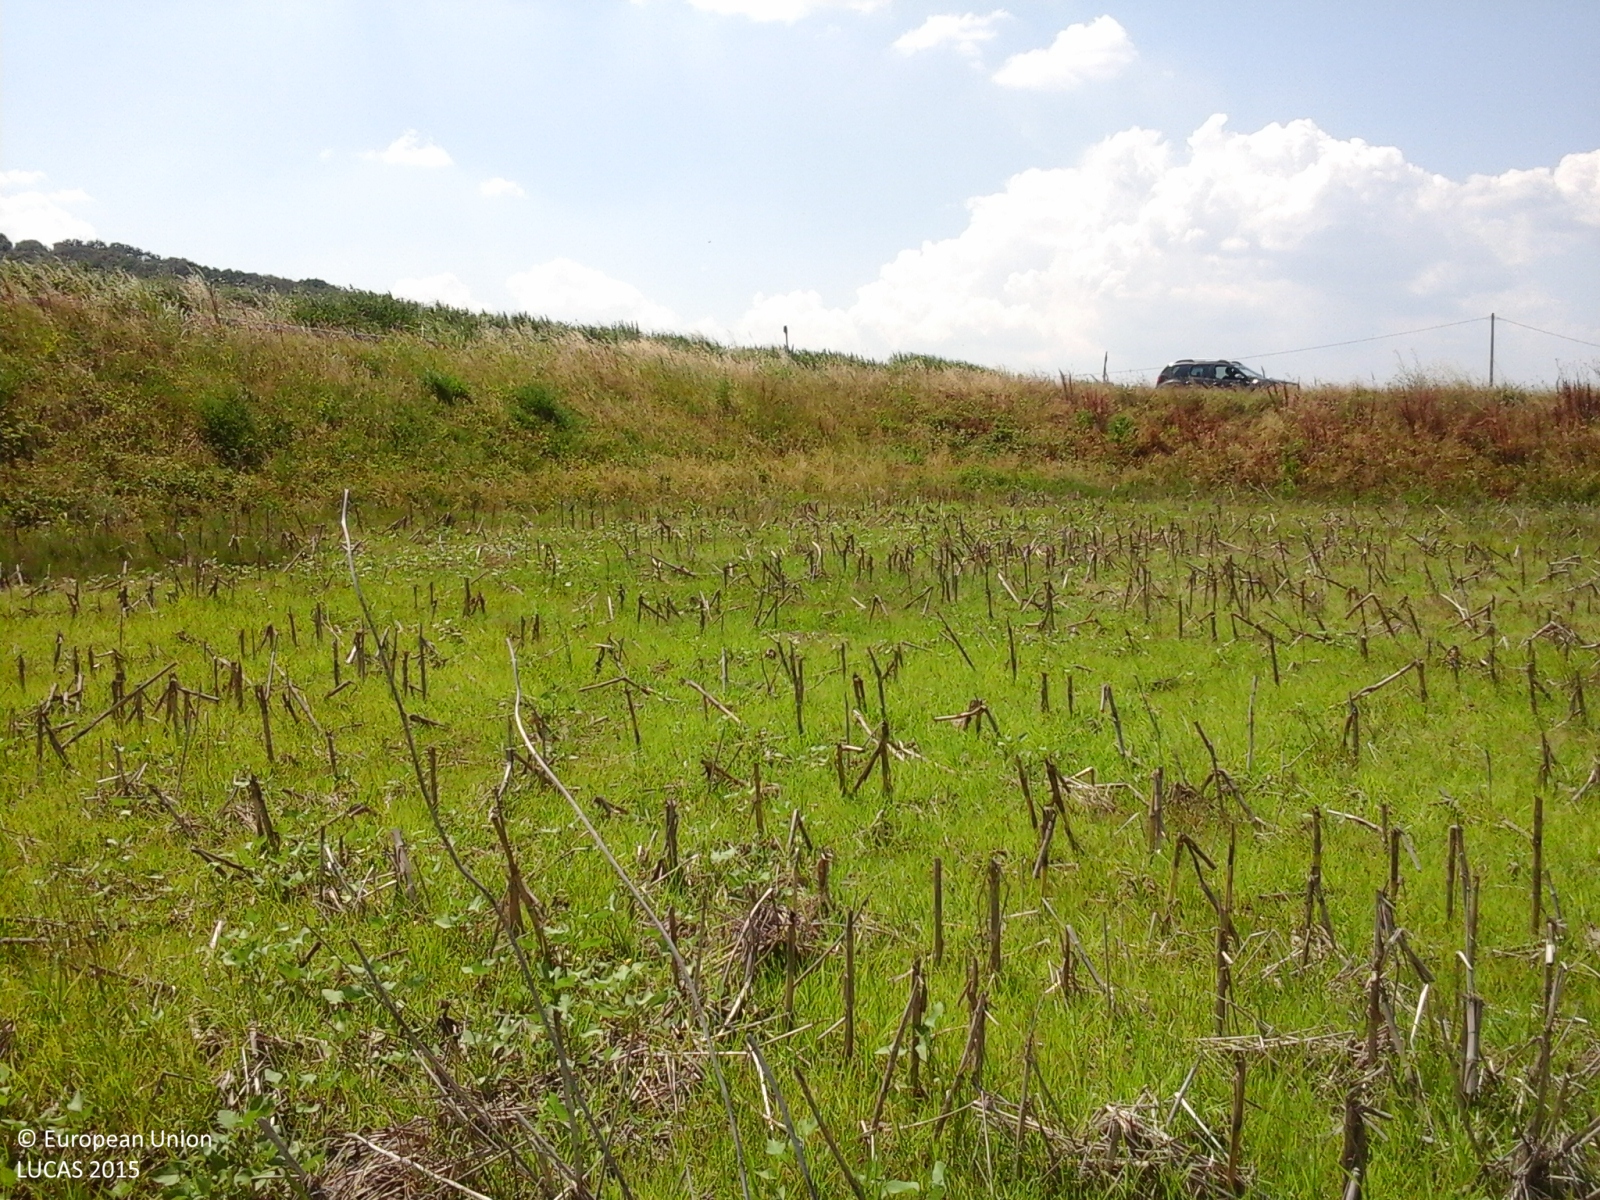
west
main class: Grassland
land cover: Spontaneously vegetated surfaces
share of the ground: > 75 %
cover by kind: herbaceous plants 100 %
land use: Agriculture (excluding fallow land and kitchen gardens)
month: June
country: IT
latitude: 43.8220
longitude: 11.0541
